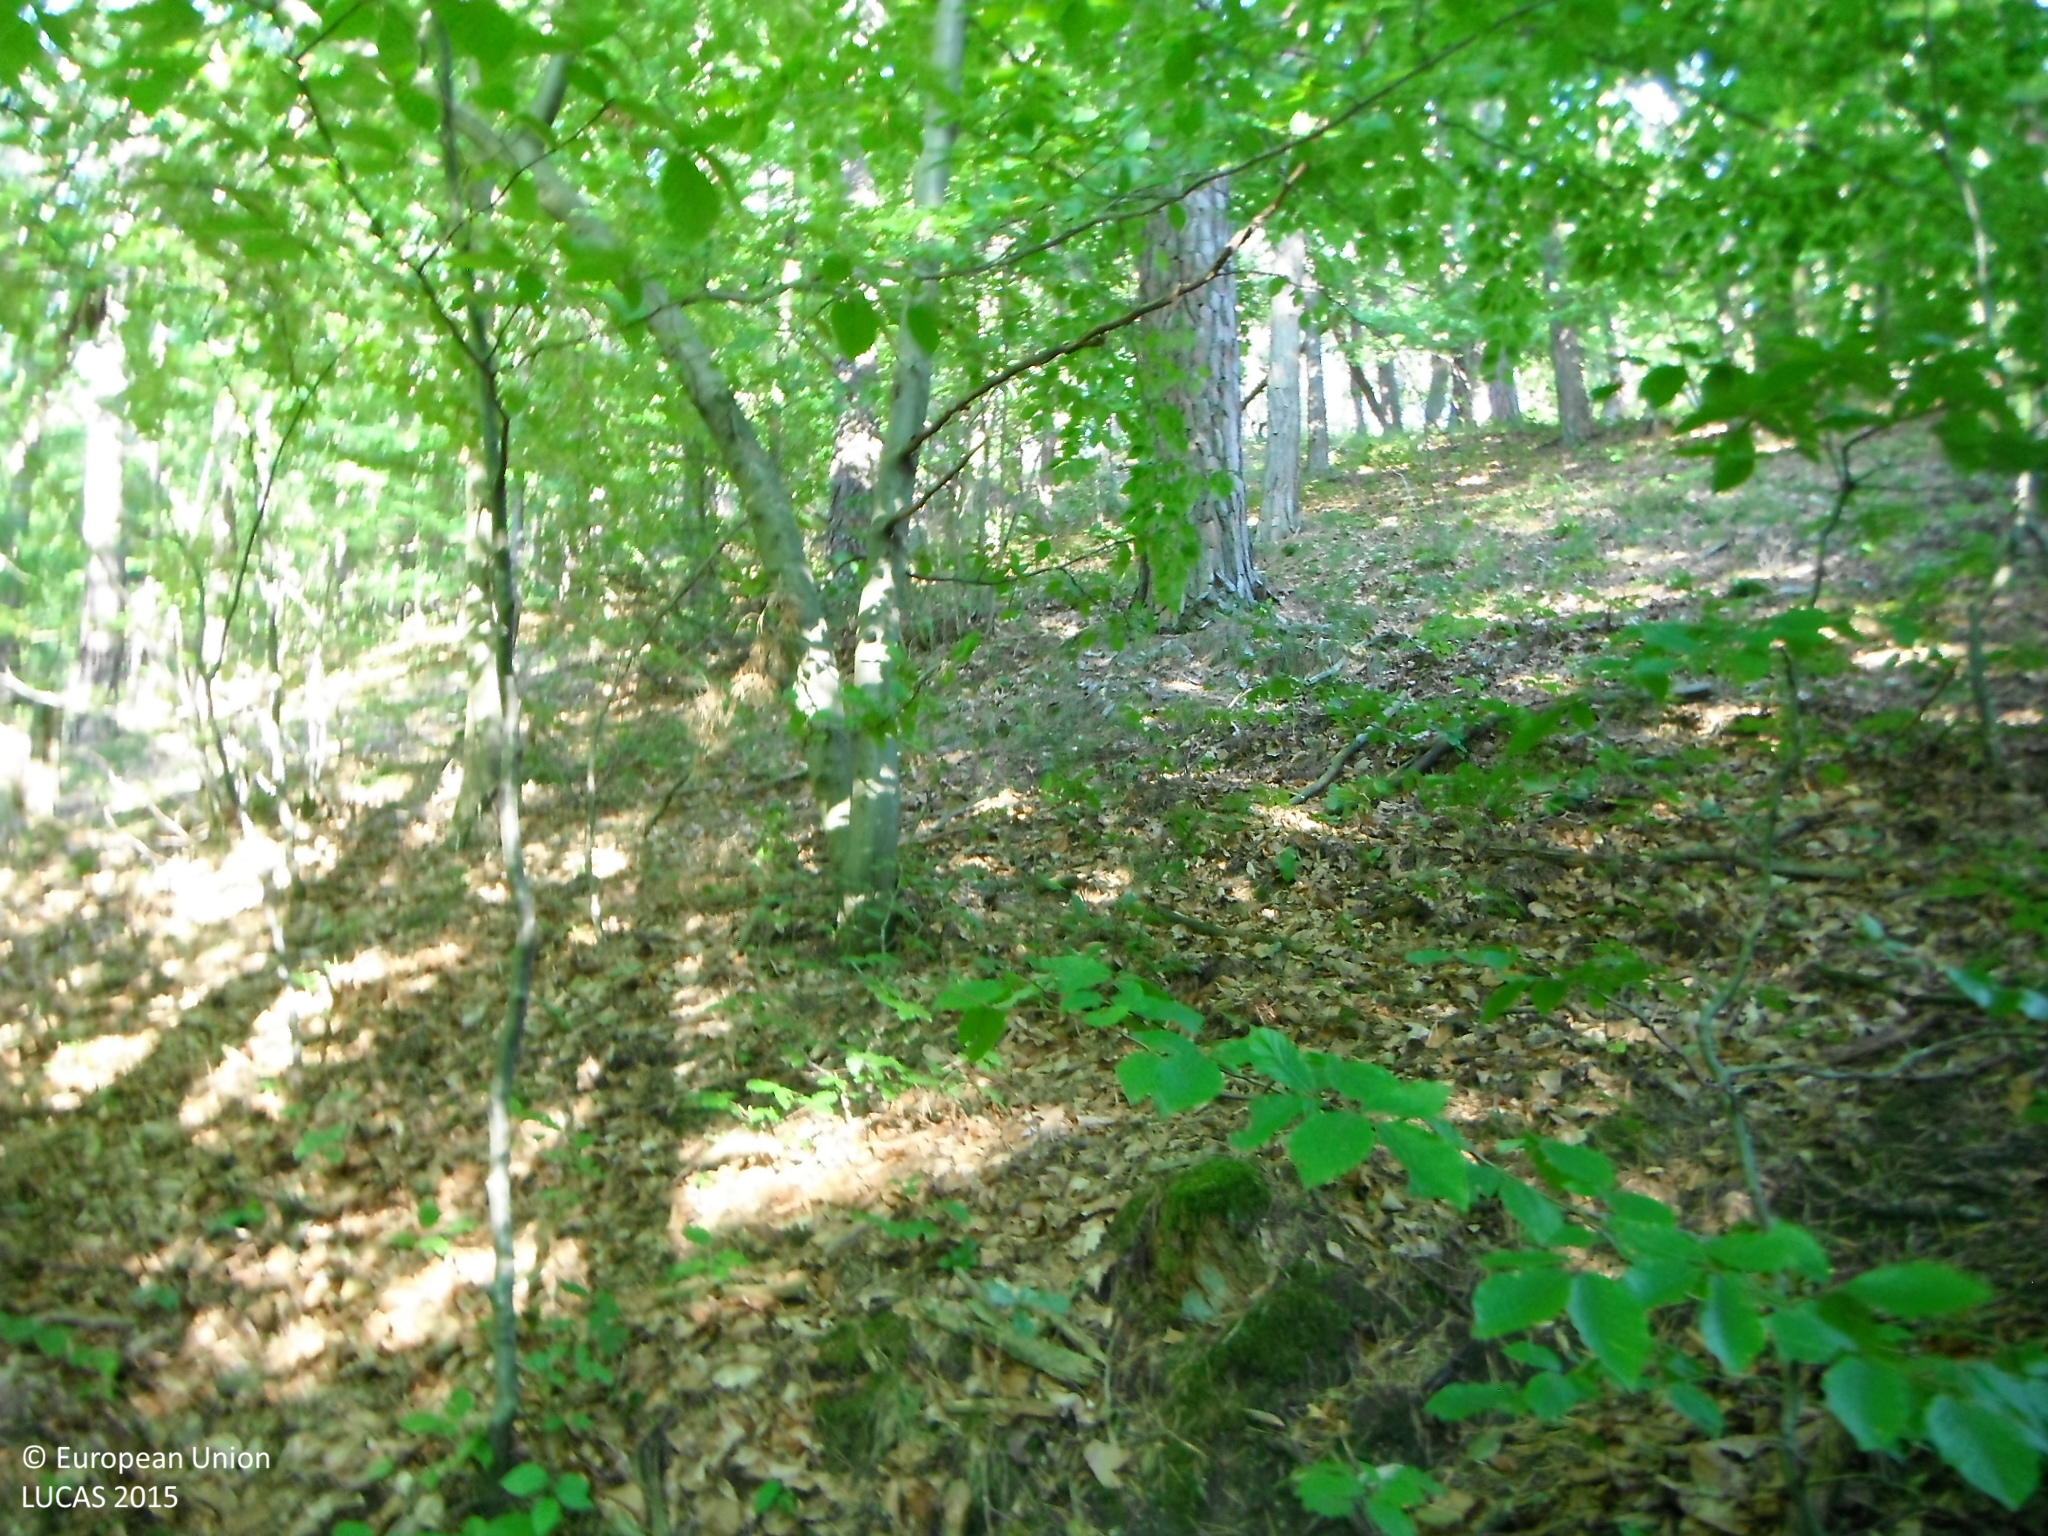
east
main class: Woodland
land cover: Pine dominated mixed woodland
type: mesophytic deciduous forest
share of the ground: > 75 %
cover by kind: broadleaved forest trees 50 %, coniferous forest trees 30 %, shrubs 15 %, herbaceous plants 5 %
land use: Forestry
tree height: > 5 m
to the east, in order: Pine dominated mixed woodland; Broadleaved woodland
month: September
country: SK
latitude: 48.8178
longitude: 18.2554
